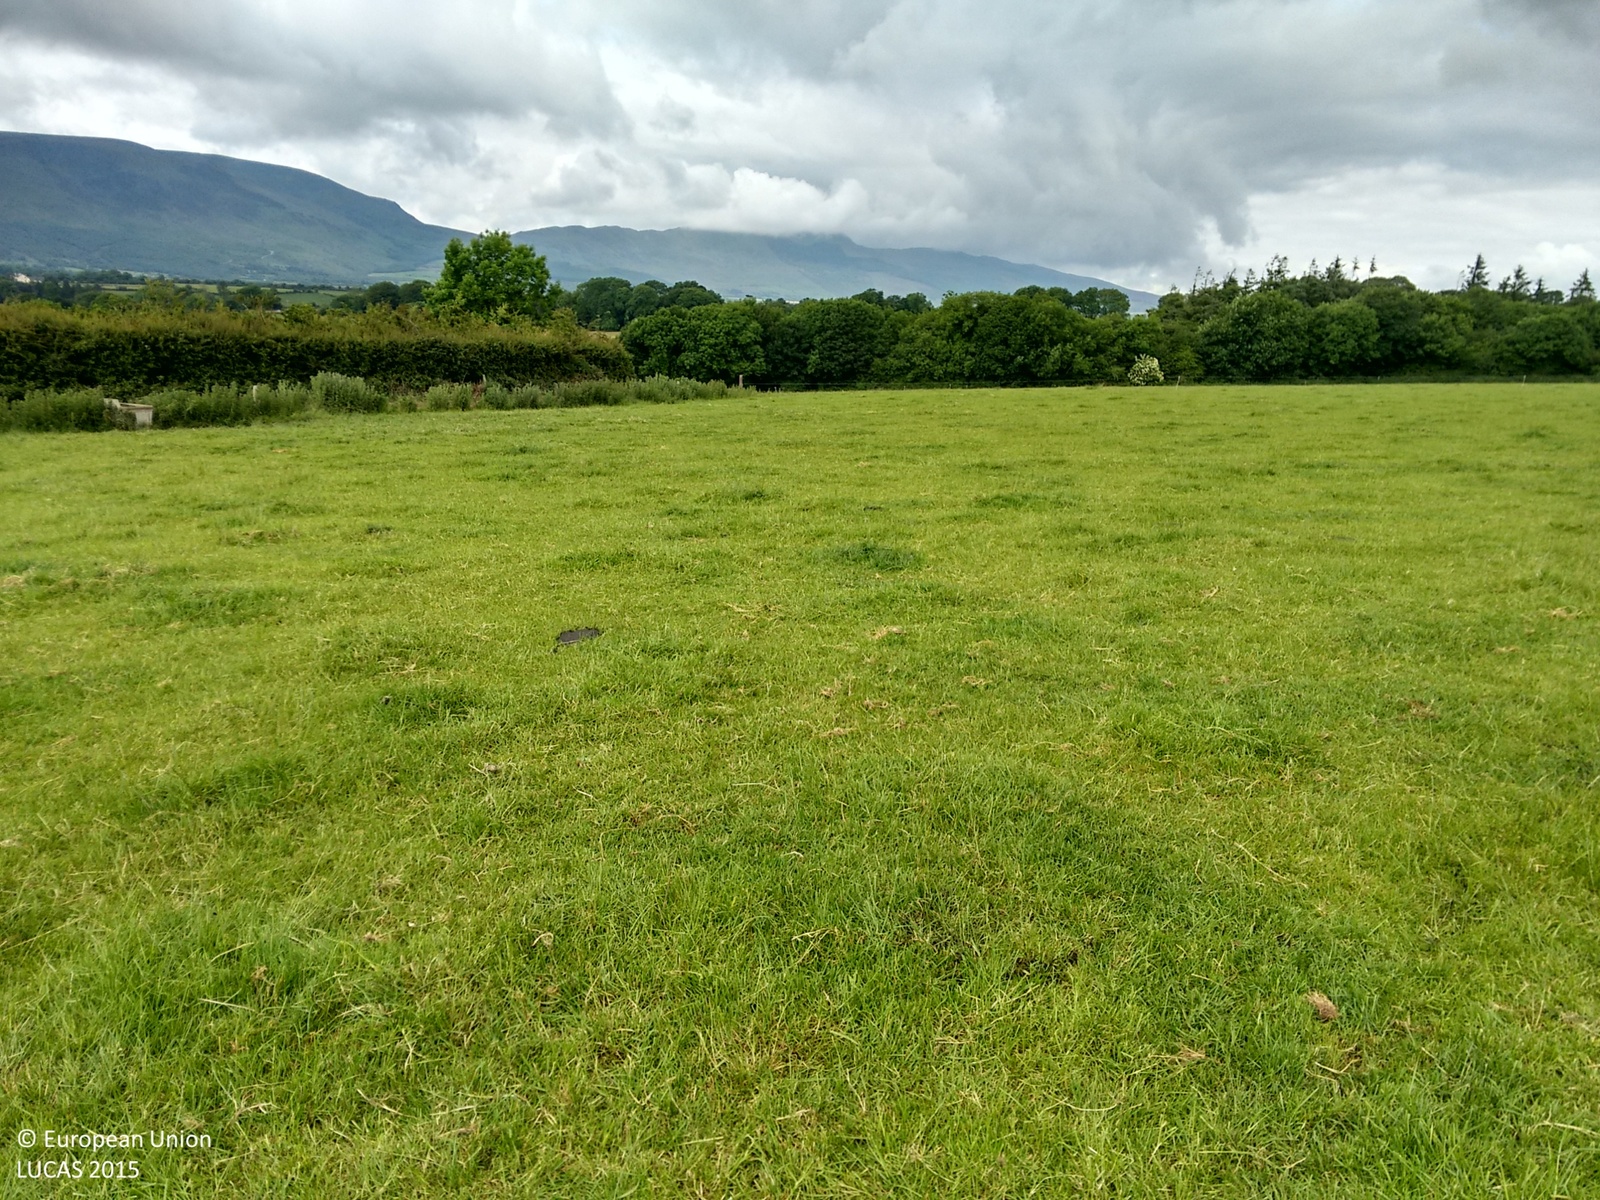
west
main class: Grassland
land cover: Grassland without tree/shrub cover
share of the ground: > 75 %
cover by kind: herbaceous plants 100 %
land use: Agriculture (excluding fallow land and kitchen gardens)
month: June
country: IE
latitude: 52.2872
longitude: -7.4413
